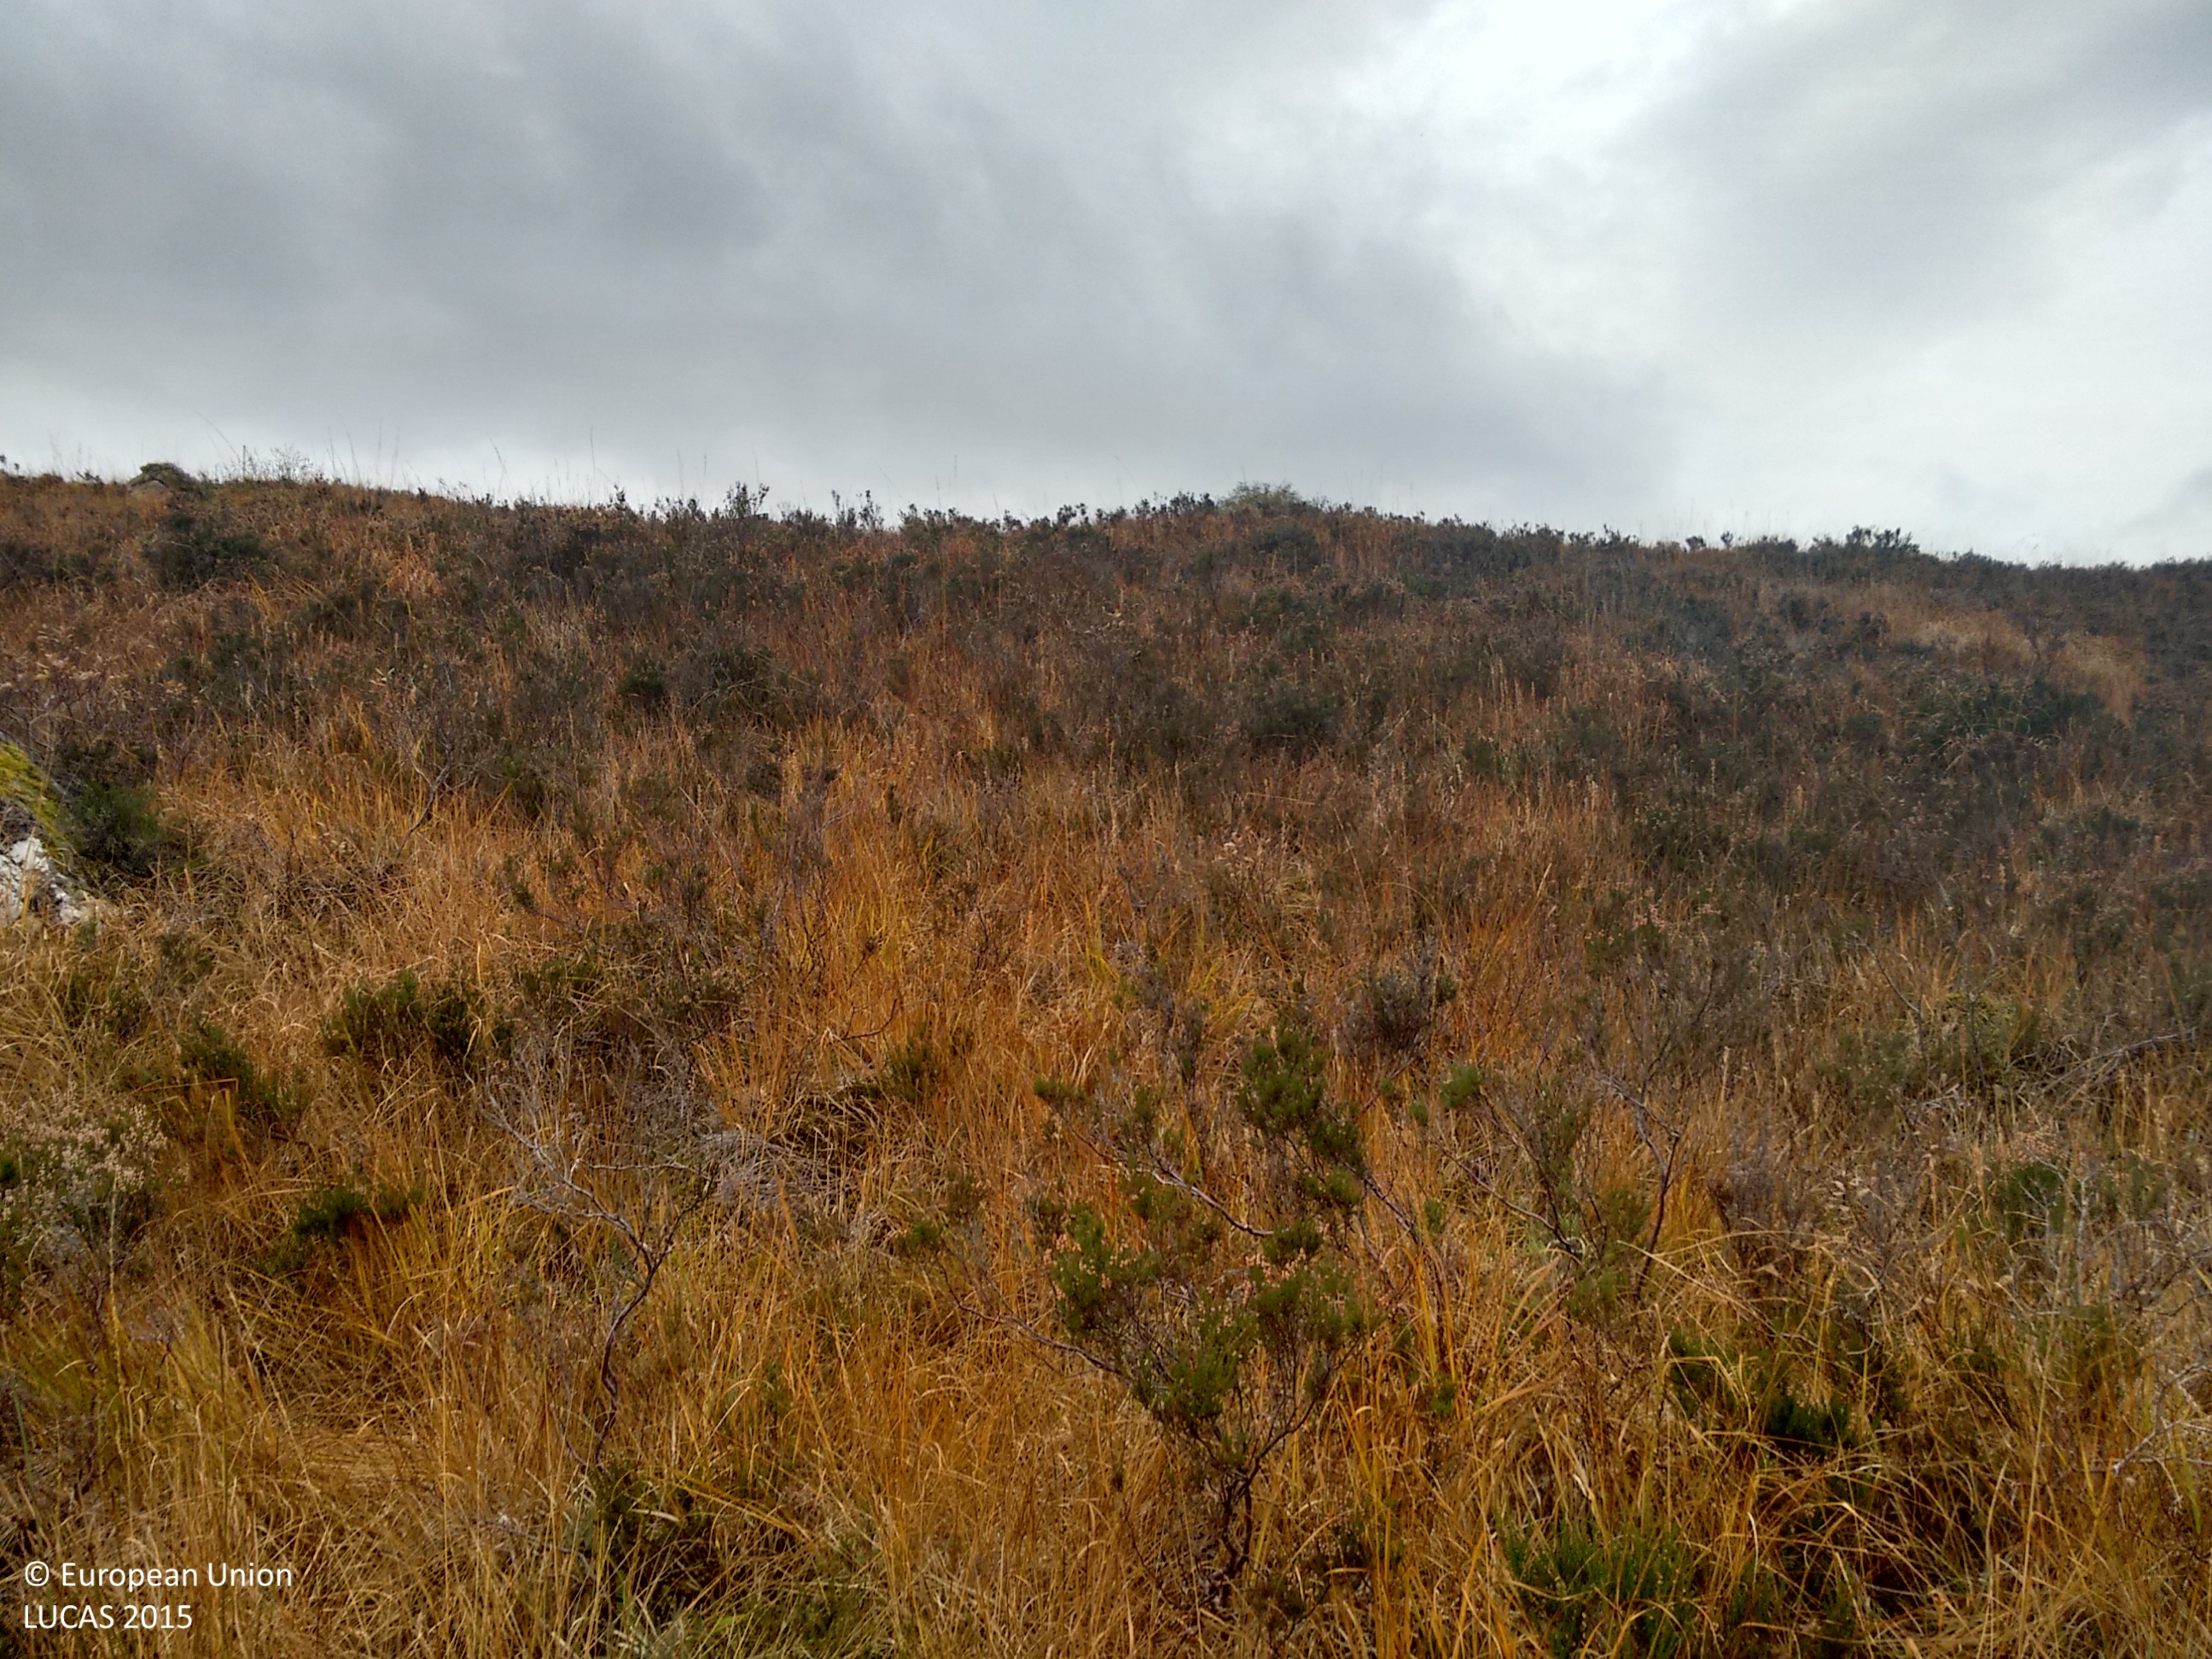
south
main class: Shrubland
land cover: Shrubland without tree cover
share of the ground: > 75 %
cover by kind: shrubs 70 %, herbaceous plants 20 %, lichens and mosses 10 %
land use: Agriculture (excluding fallow land and kitchen gardens)
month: November
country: GB
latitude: 57.1157
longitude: -4.9834
